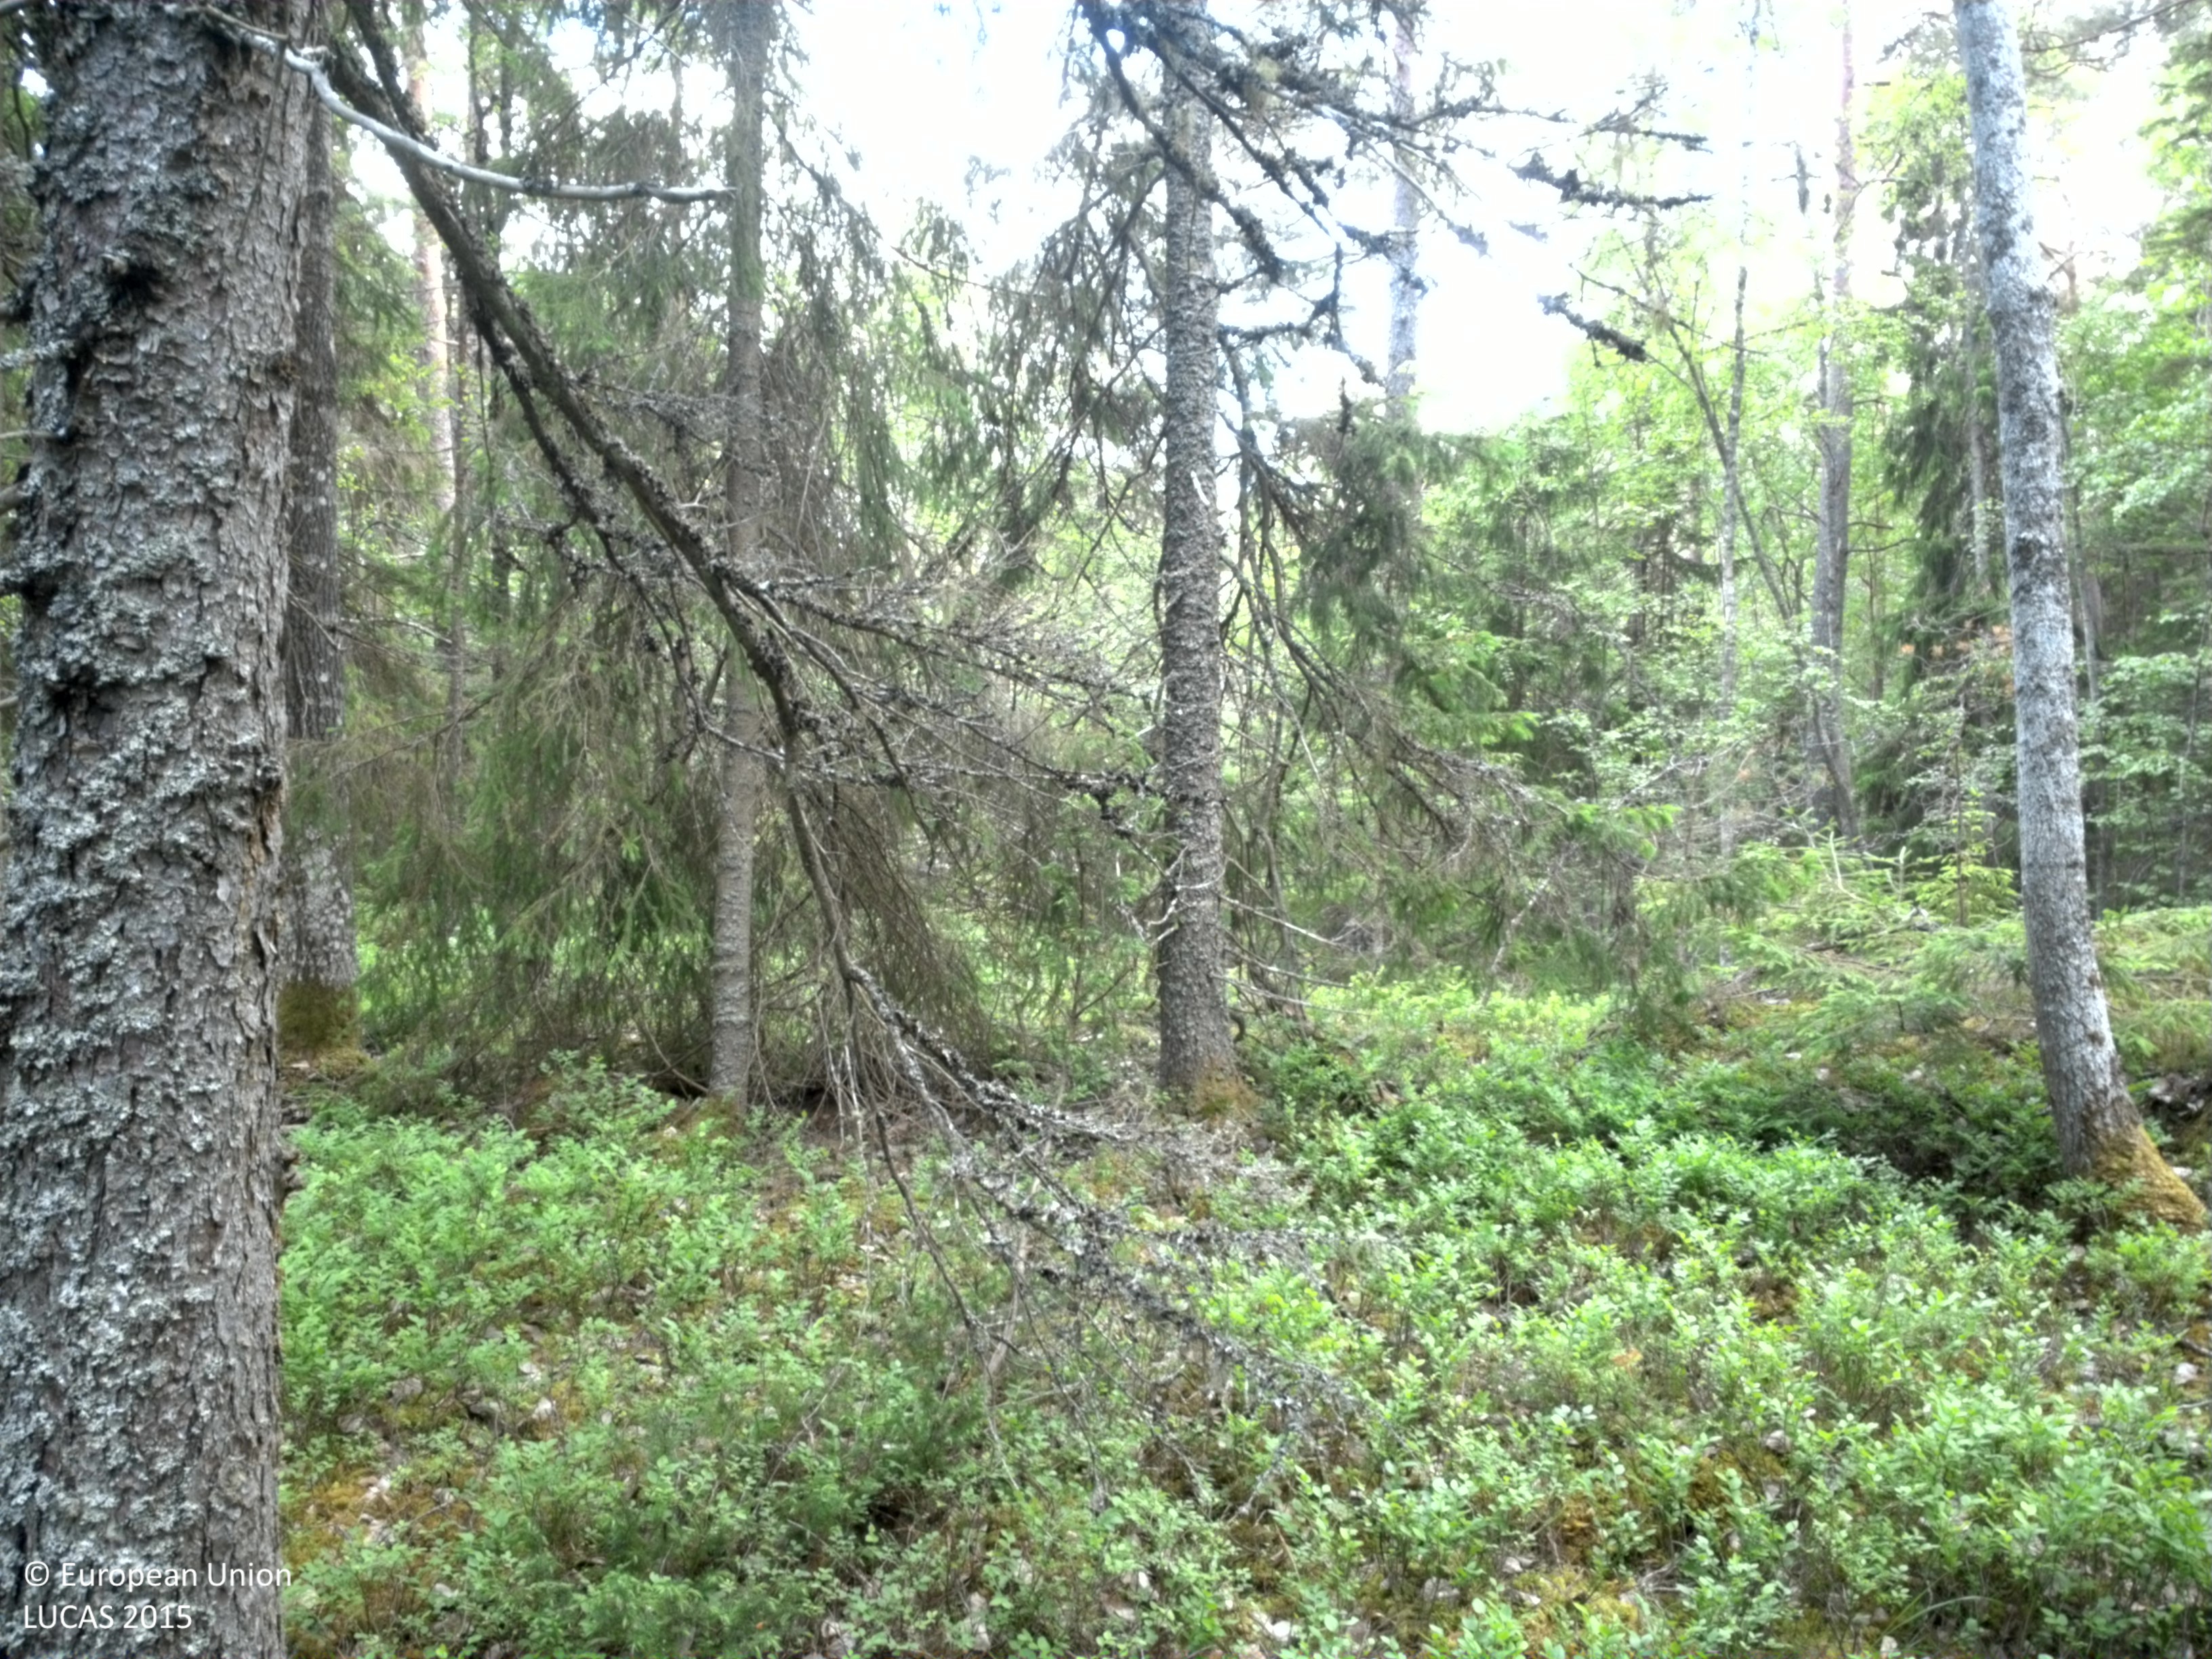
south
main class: Woodland
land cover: Spruce dominated coniferous woodland
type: boreal forest
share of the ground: 50 - 75 %
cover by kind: coniferous forest trees 55 %, herbaceous plants 20 %, lichens and mosses 20 %, broadleaved forest trees 5 %
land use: Forestry
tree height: > 5 m
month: June
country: SE
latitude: 60.0939
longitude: 18.6831
